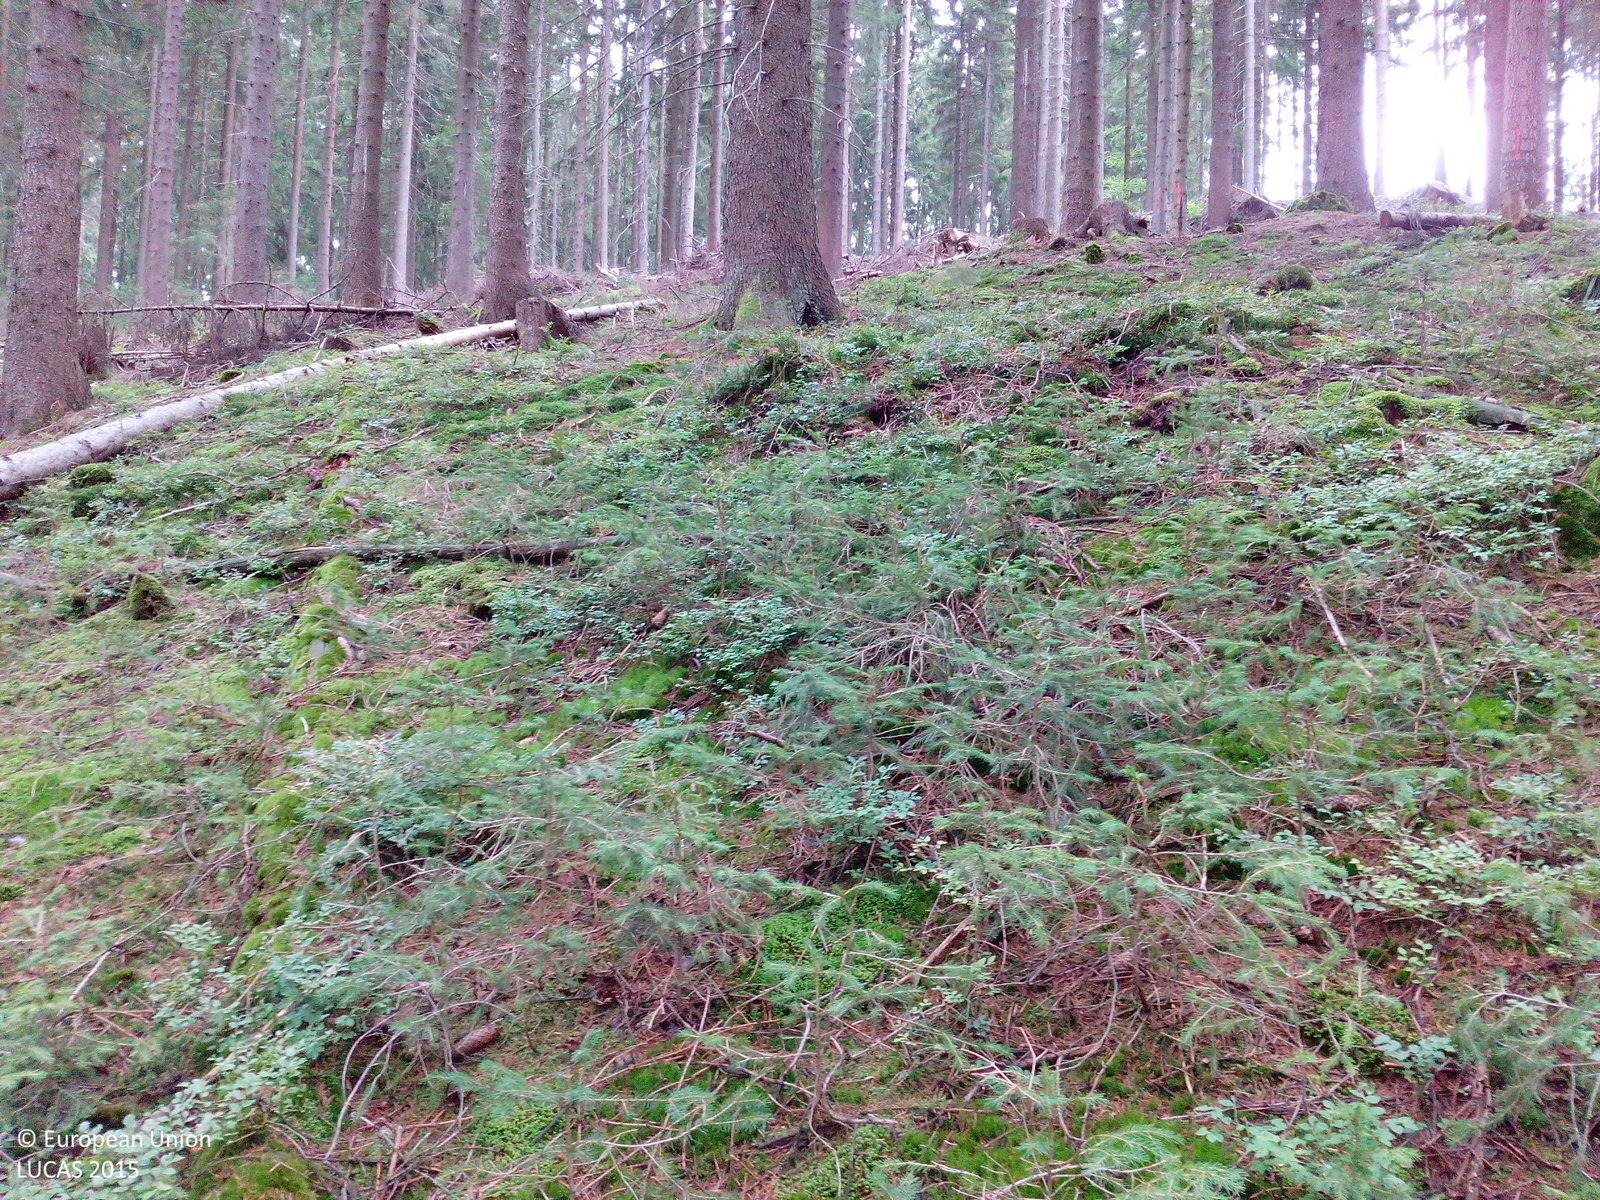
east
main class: Woodland
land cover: Spruce dominated coniferous woodland
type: hemiboreal forest and nemoral coniferous forest and mixed broadleaved-coniferous forest
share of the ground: > 75 %
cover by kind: coniferous forest trees 85 %, lichens and mosses 10 %, shrubs 5 %
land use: Forestry
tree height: > 5 m
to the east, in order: Spruce dominated coniferous woodland; Tracks; Spruce dominated coniferous woodland; Tracks; Spruce dominated coniferous woodland; Tracks; Spruce dominated coniferous woodland; Tracks; Spruce dominated coniferous woodland; Tracks; Spruce dominated coniferous woodland; Tracks; Spruce dominated coniferous woodland
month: August
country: DE
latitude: 50.4092
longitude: 11.4208
